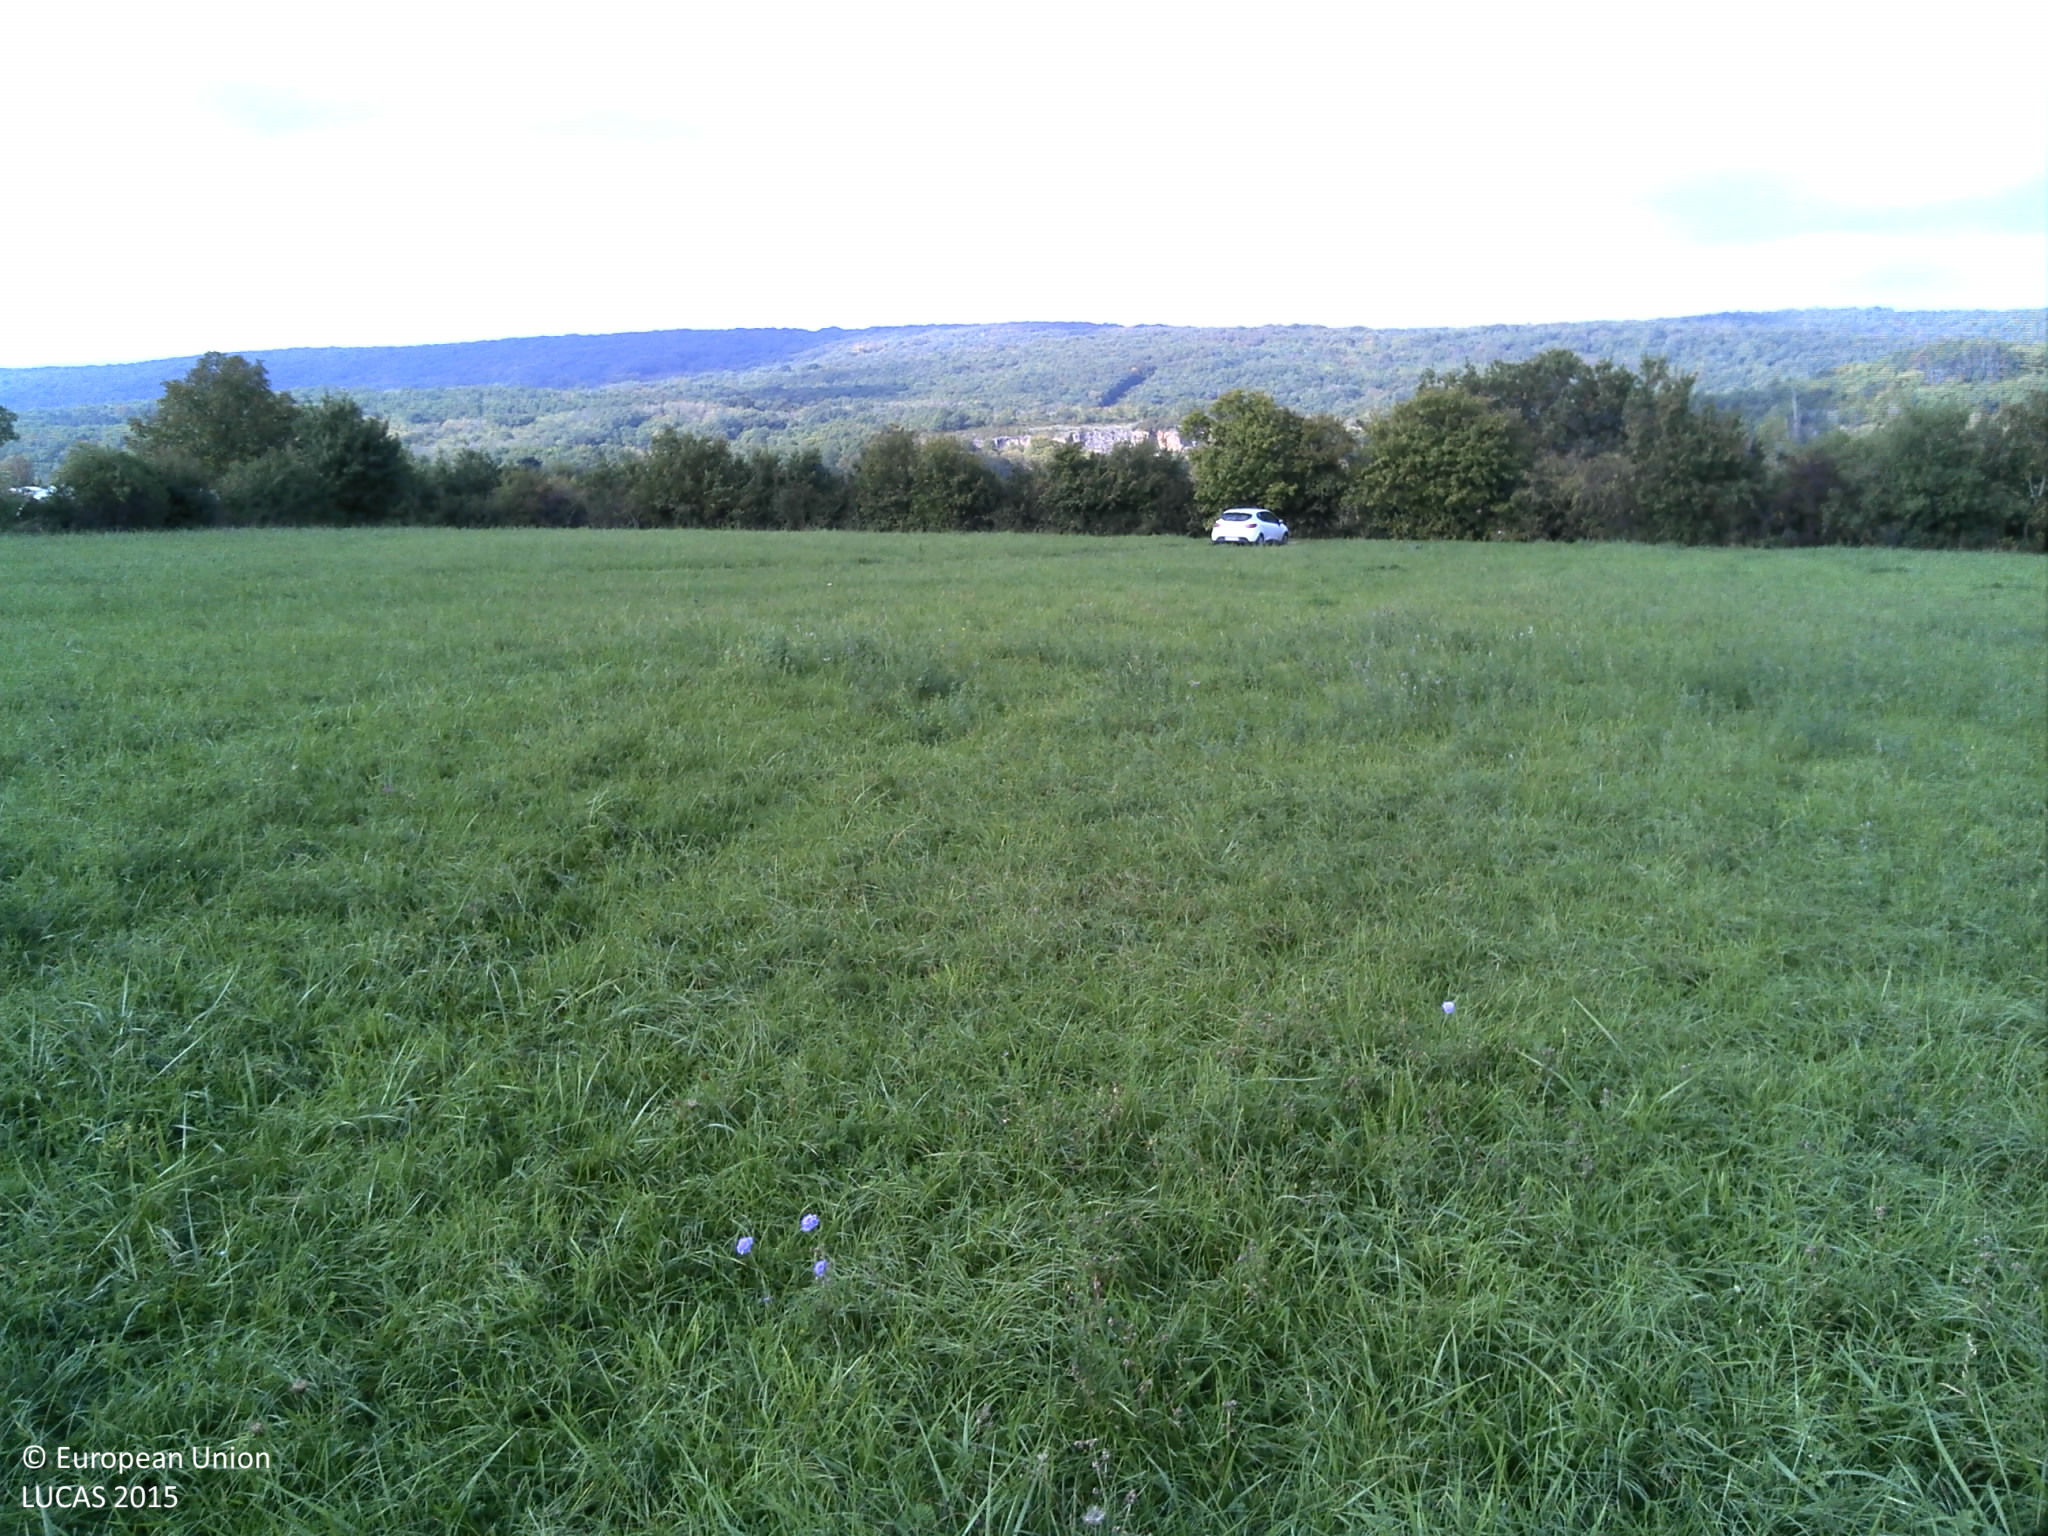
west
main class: Grassland
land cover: Grassland without tree/shrub cover
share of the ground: > 75 %
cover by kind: herbaceous plants 100 %
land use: Agriculture (excluding fallow land and kitchen gardens)
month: October
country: FR
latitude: 46.6071
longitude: 4.8707
